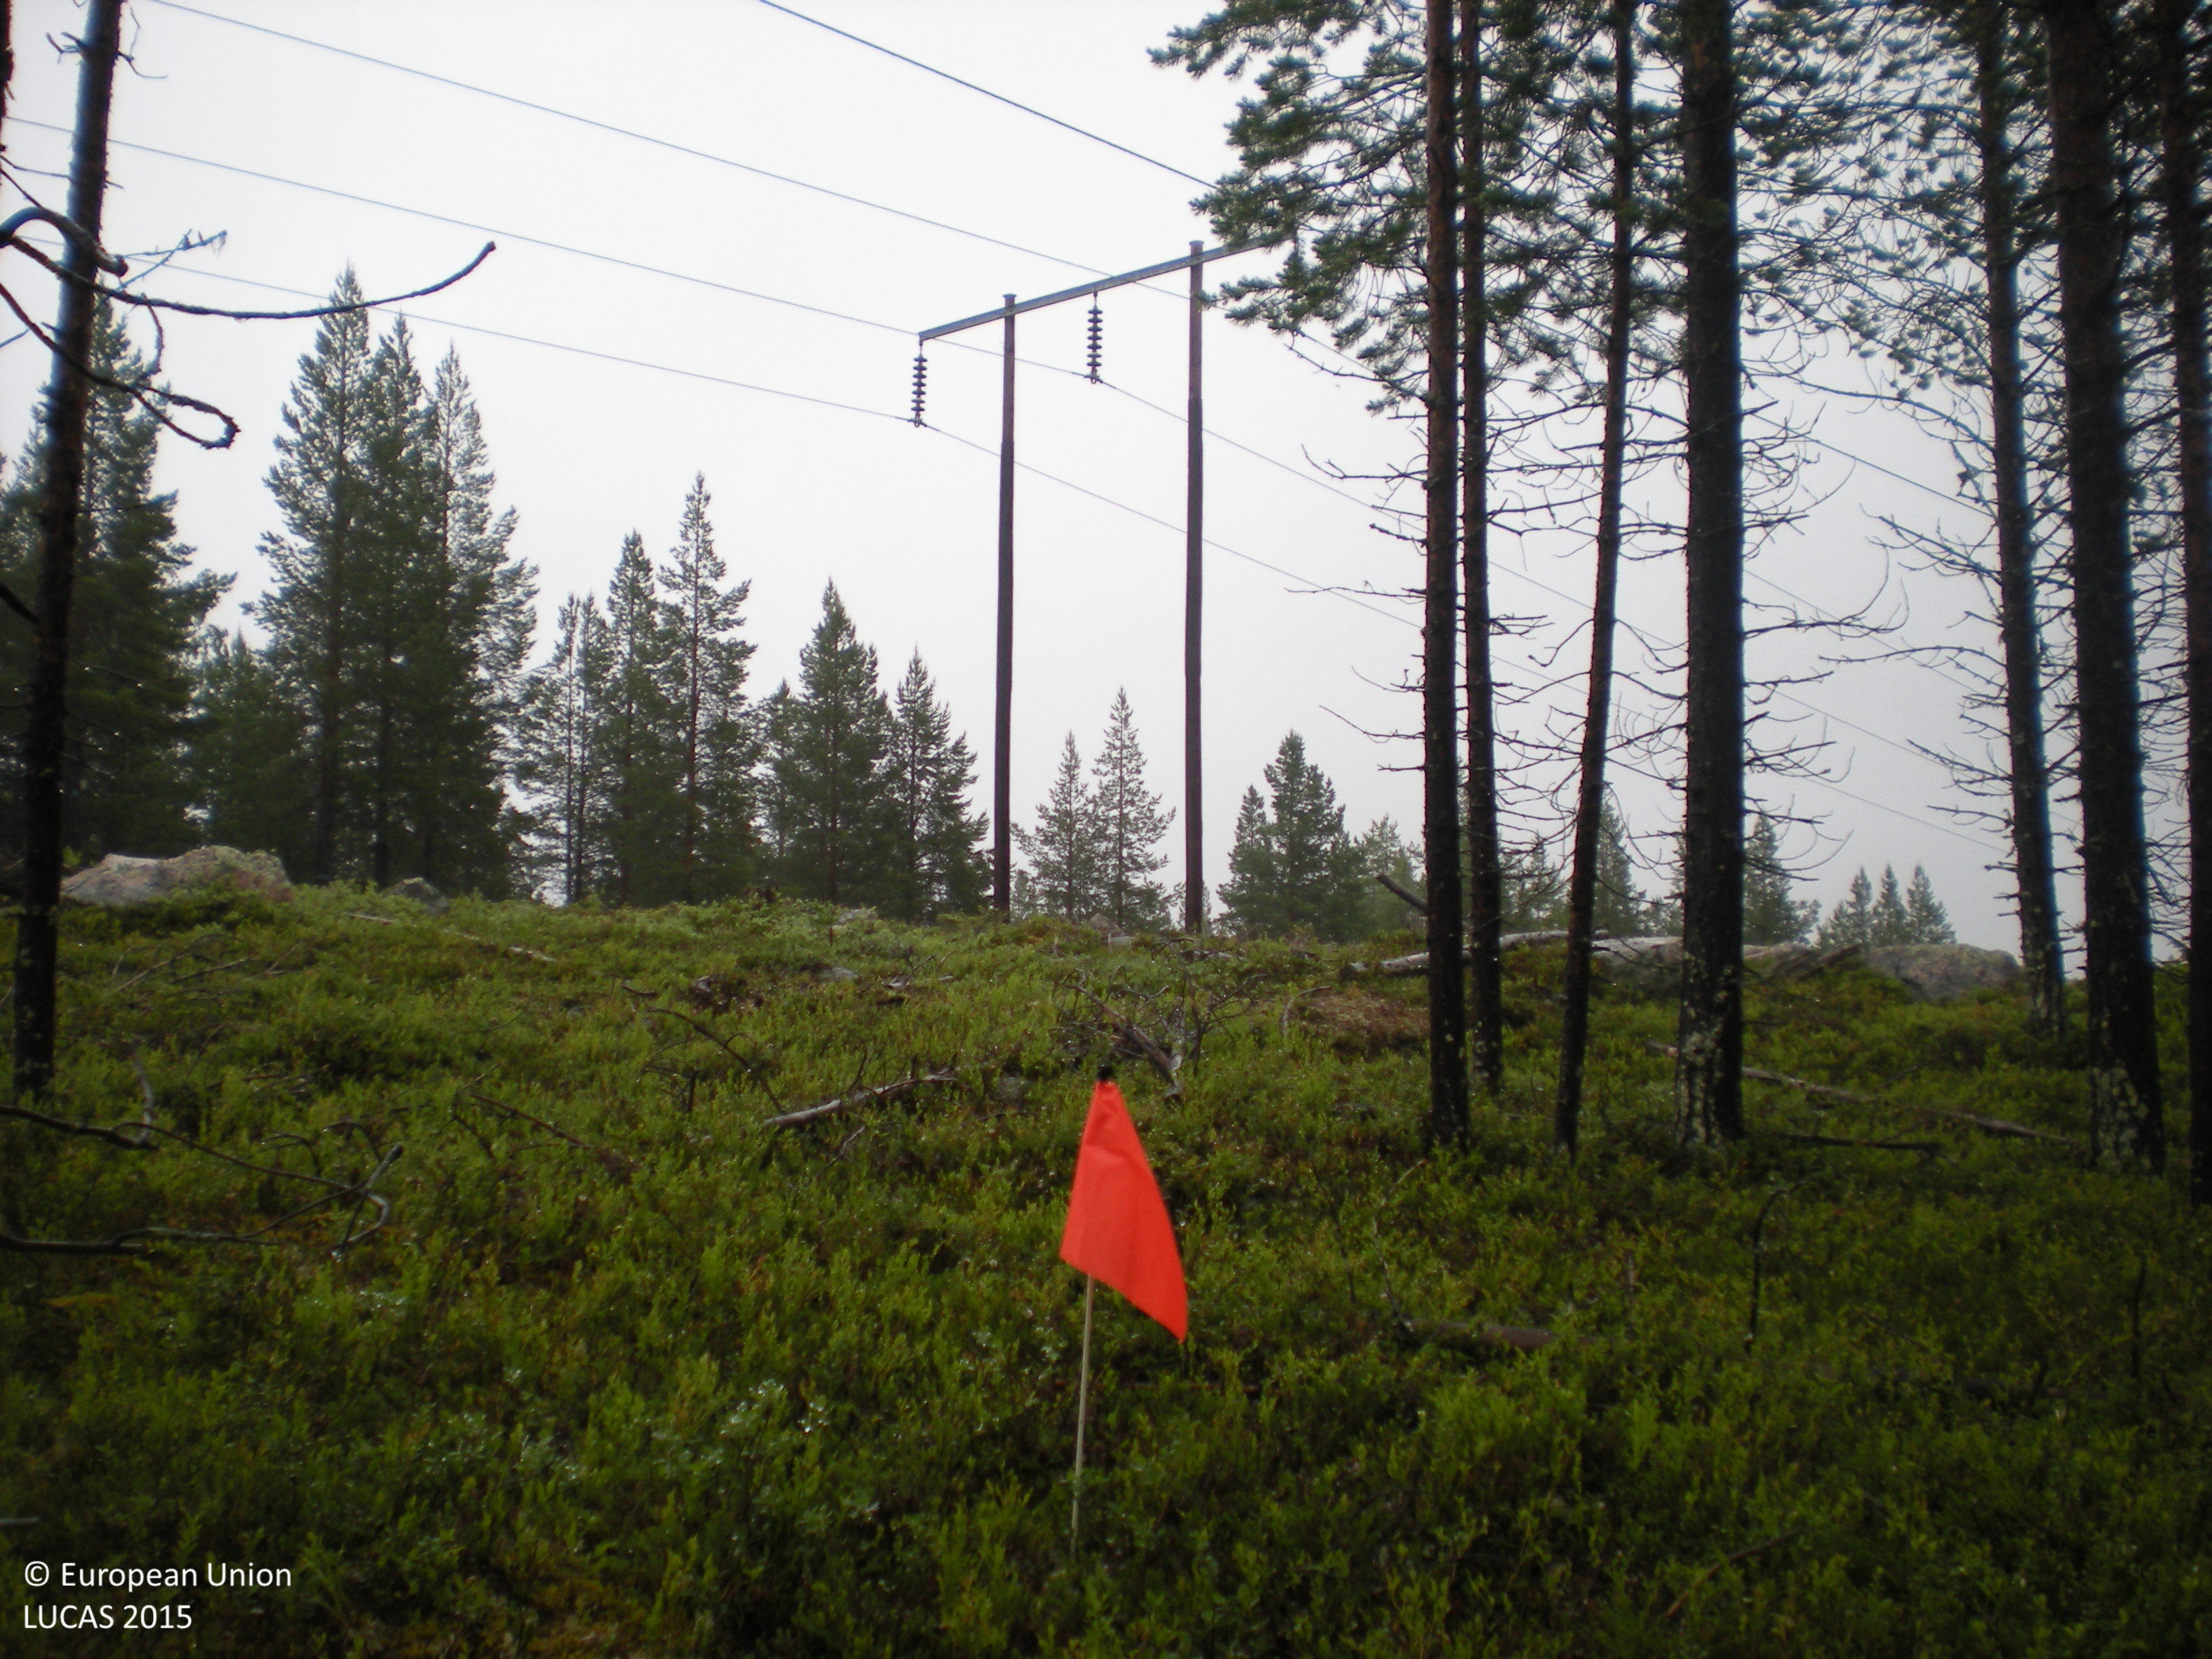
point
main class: Woodland
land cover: Pine dominated coniferous woodland
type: boreal forest
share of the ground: 50 - 75 %
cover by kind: coniferous forest trees 60 %, shrubs 35 %, lichens and mosses 5 %
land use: Forestry
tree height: > 5 m
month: July
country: SE
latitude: 65.9655
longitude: 18.2512
